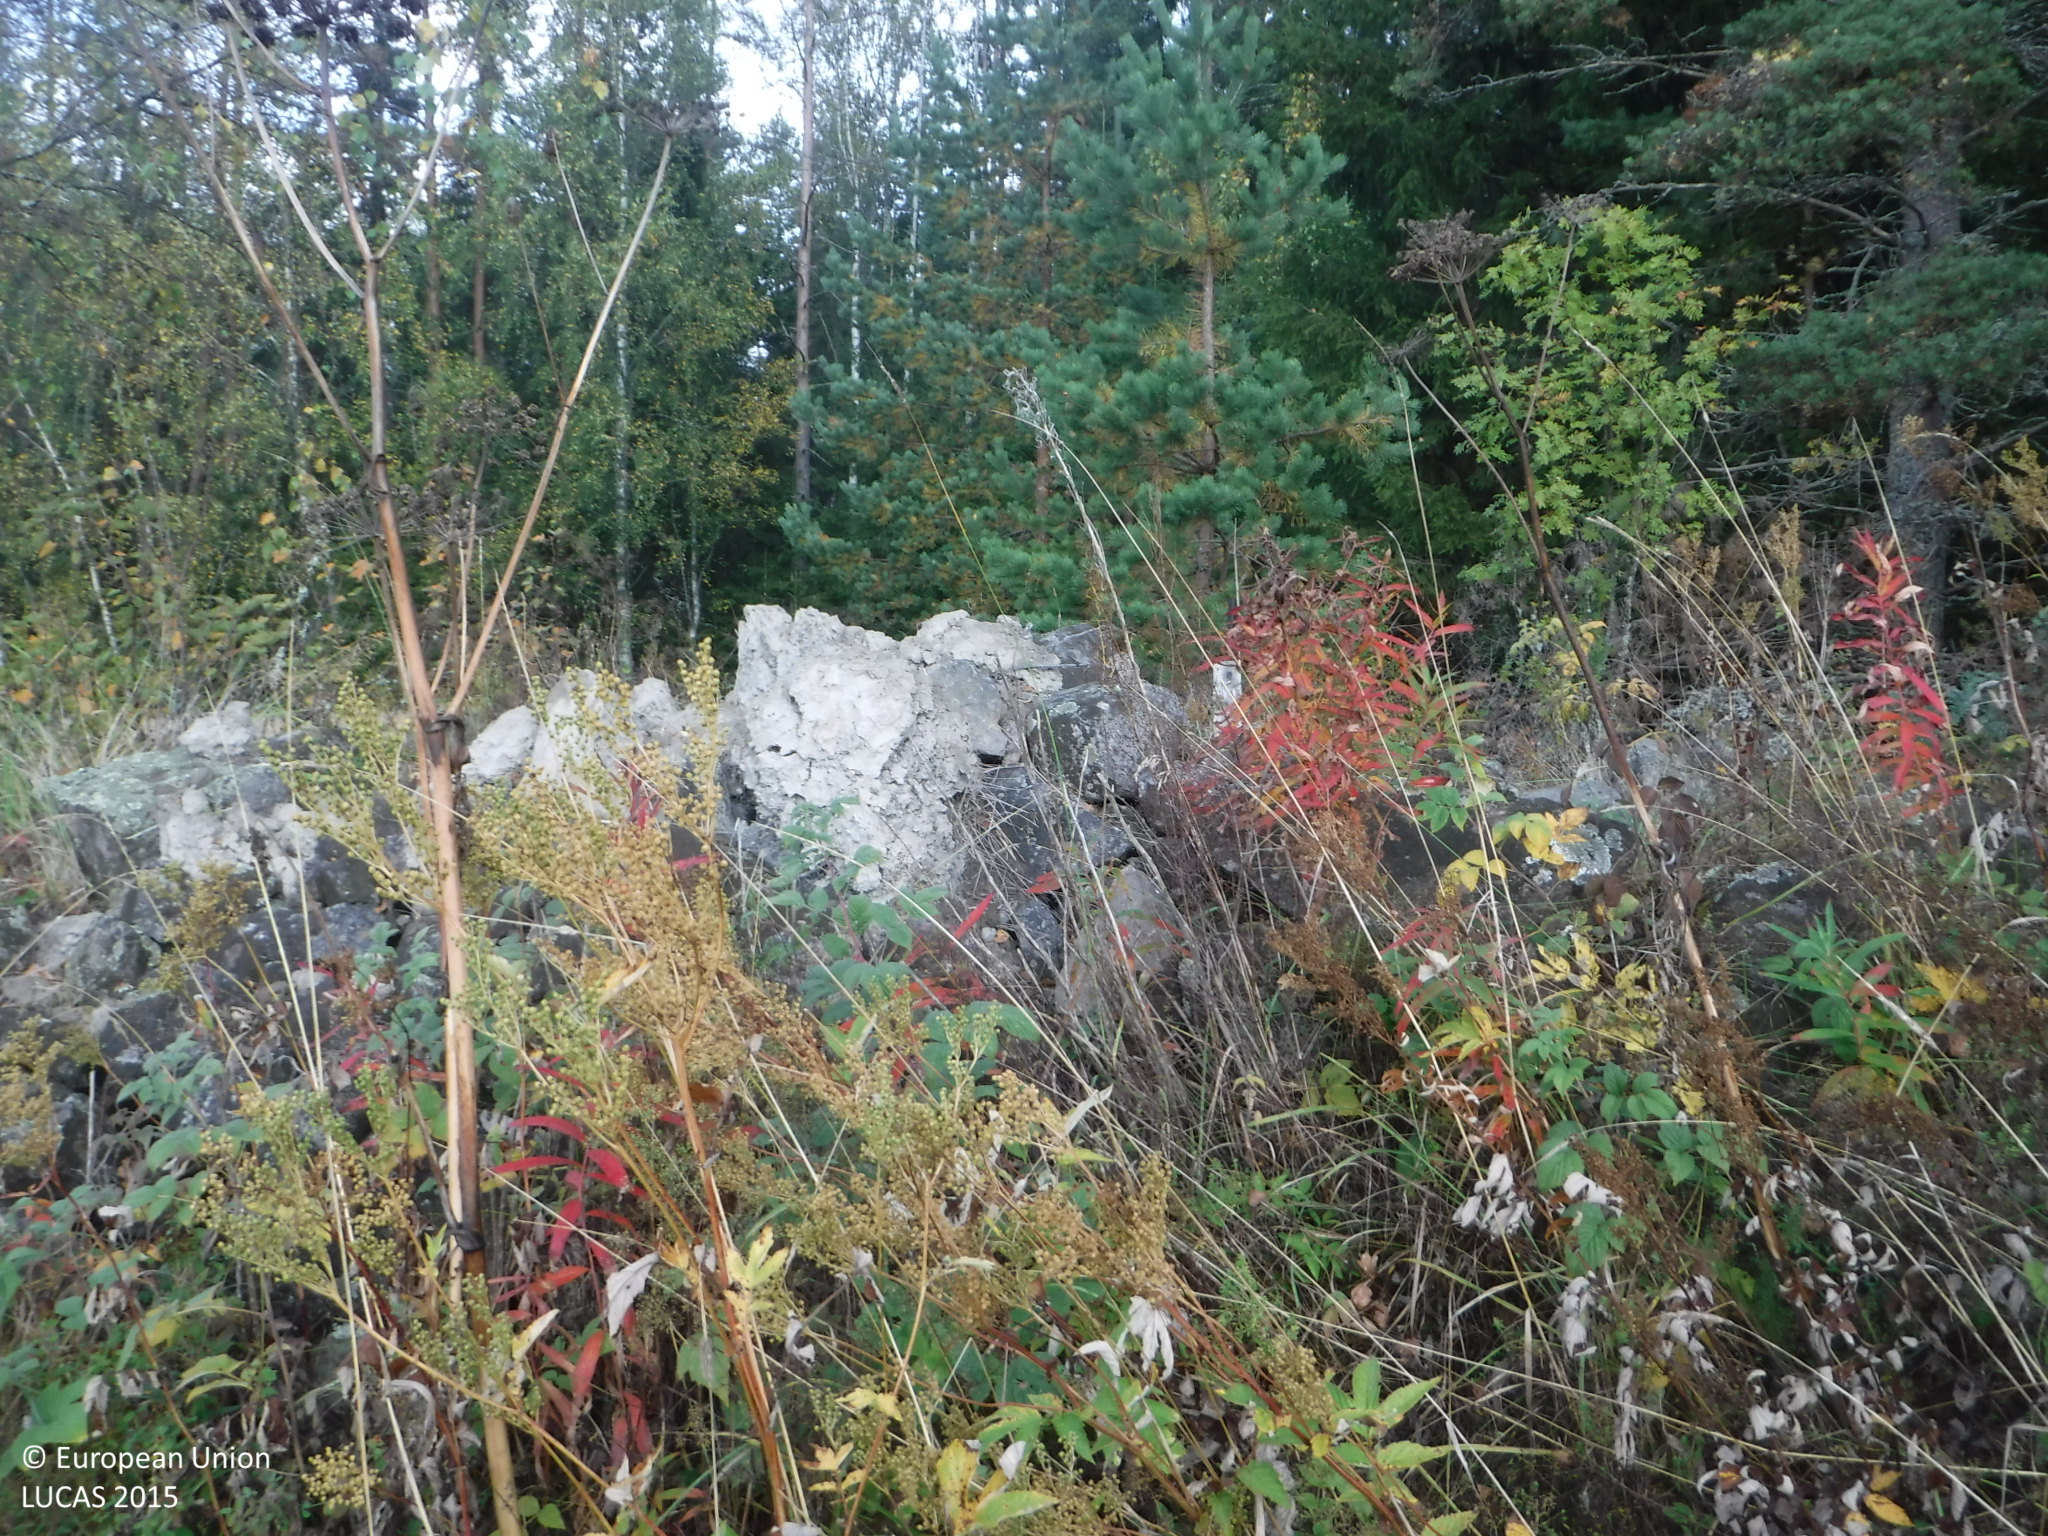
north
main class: Cropland
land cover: Other leguminous and mixtures for fodder
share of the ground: > 75 %
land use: Agriculture (excluding fallow land and kitchen gardens)
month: September
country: FI
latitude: 61.6880
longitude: 21.5987
